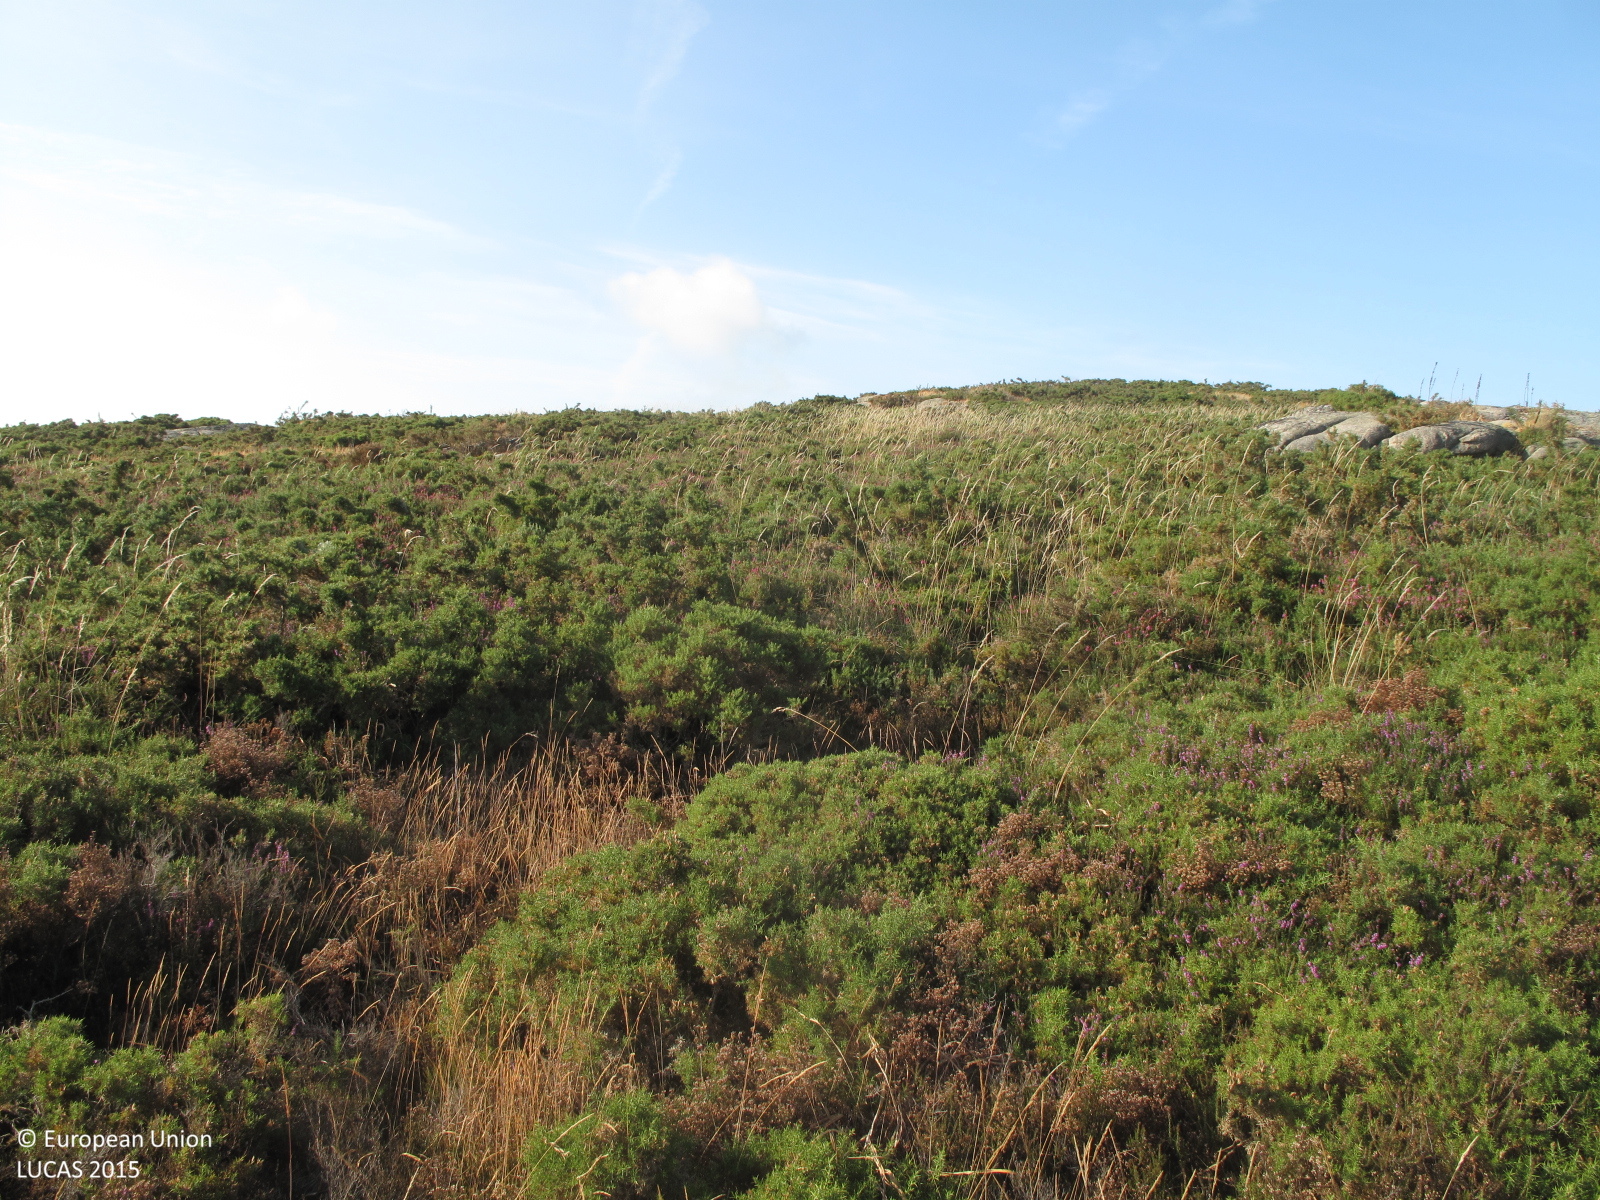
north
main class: Shrubland
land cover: Shrubland without tree cover
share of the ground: > 75 %
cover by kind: shrubs 90 %, consolidated bare surface 10 %
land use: Semi-natural and natural areas not in use
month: July
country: ES
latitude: 43.4827
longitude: -8.2922
